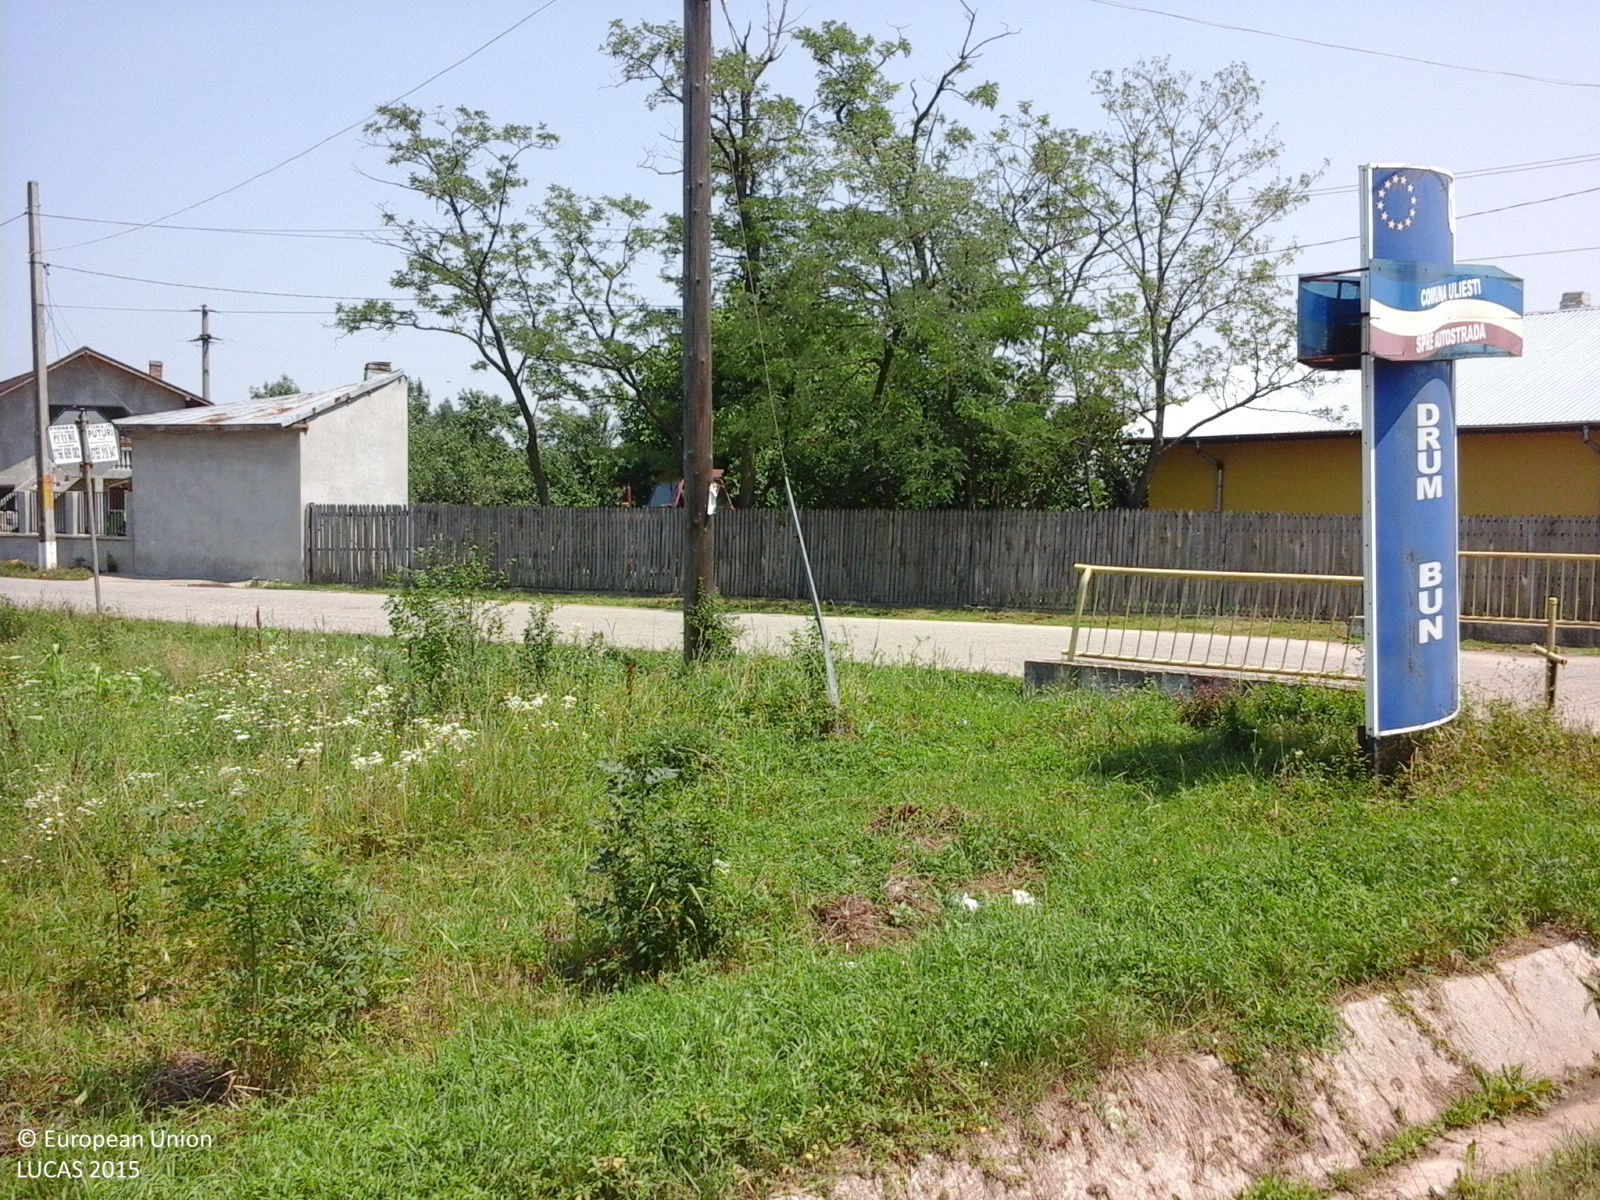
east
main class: Grassland
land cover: Spontaneously vegetated surfaces
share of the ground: > 75 %
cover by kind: herbaceous plants 100 %
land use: Fallow land
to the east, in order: Paved roads, cycling and walking lanes; Grass margins; Ditches and canals; Electric lines; Abandoned hedges; Spontaneously vegetated surfaces; Artificial constructions in urban areas; Maize; Ditches and canals; Lines of trees; Maize; Electric lines; Maize; Grass margins; Tracks; Grass margins; Common wheat
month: July
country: RO
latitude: 44.6222
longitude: 25.4039
